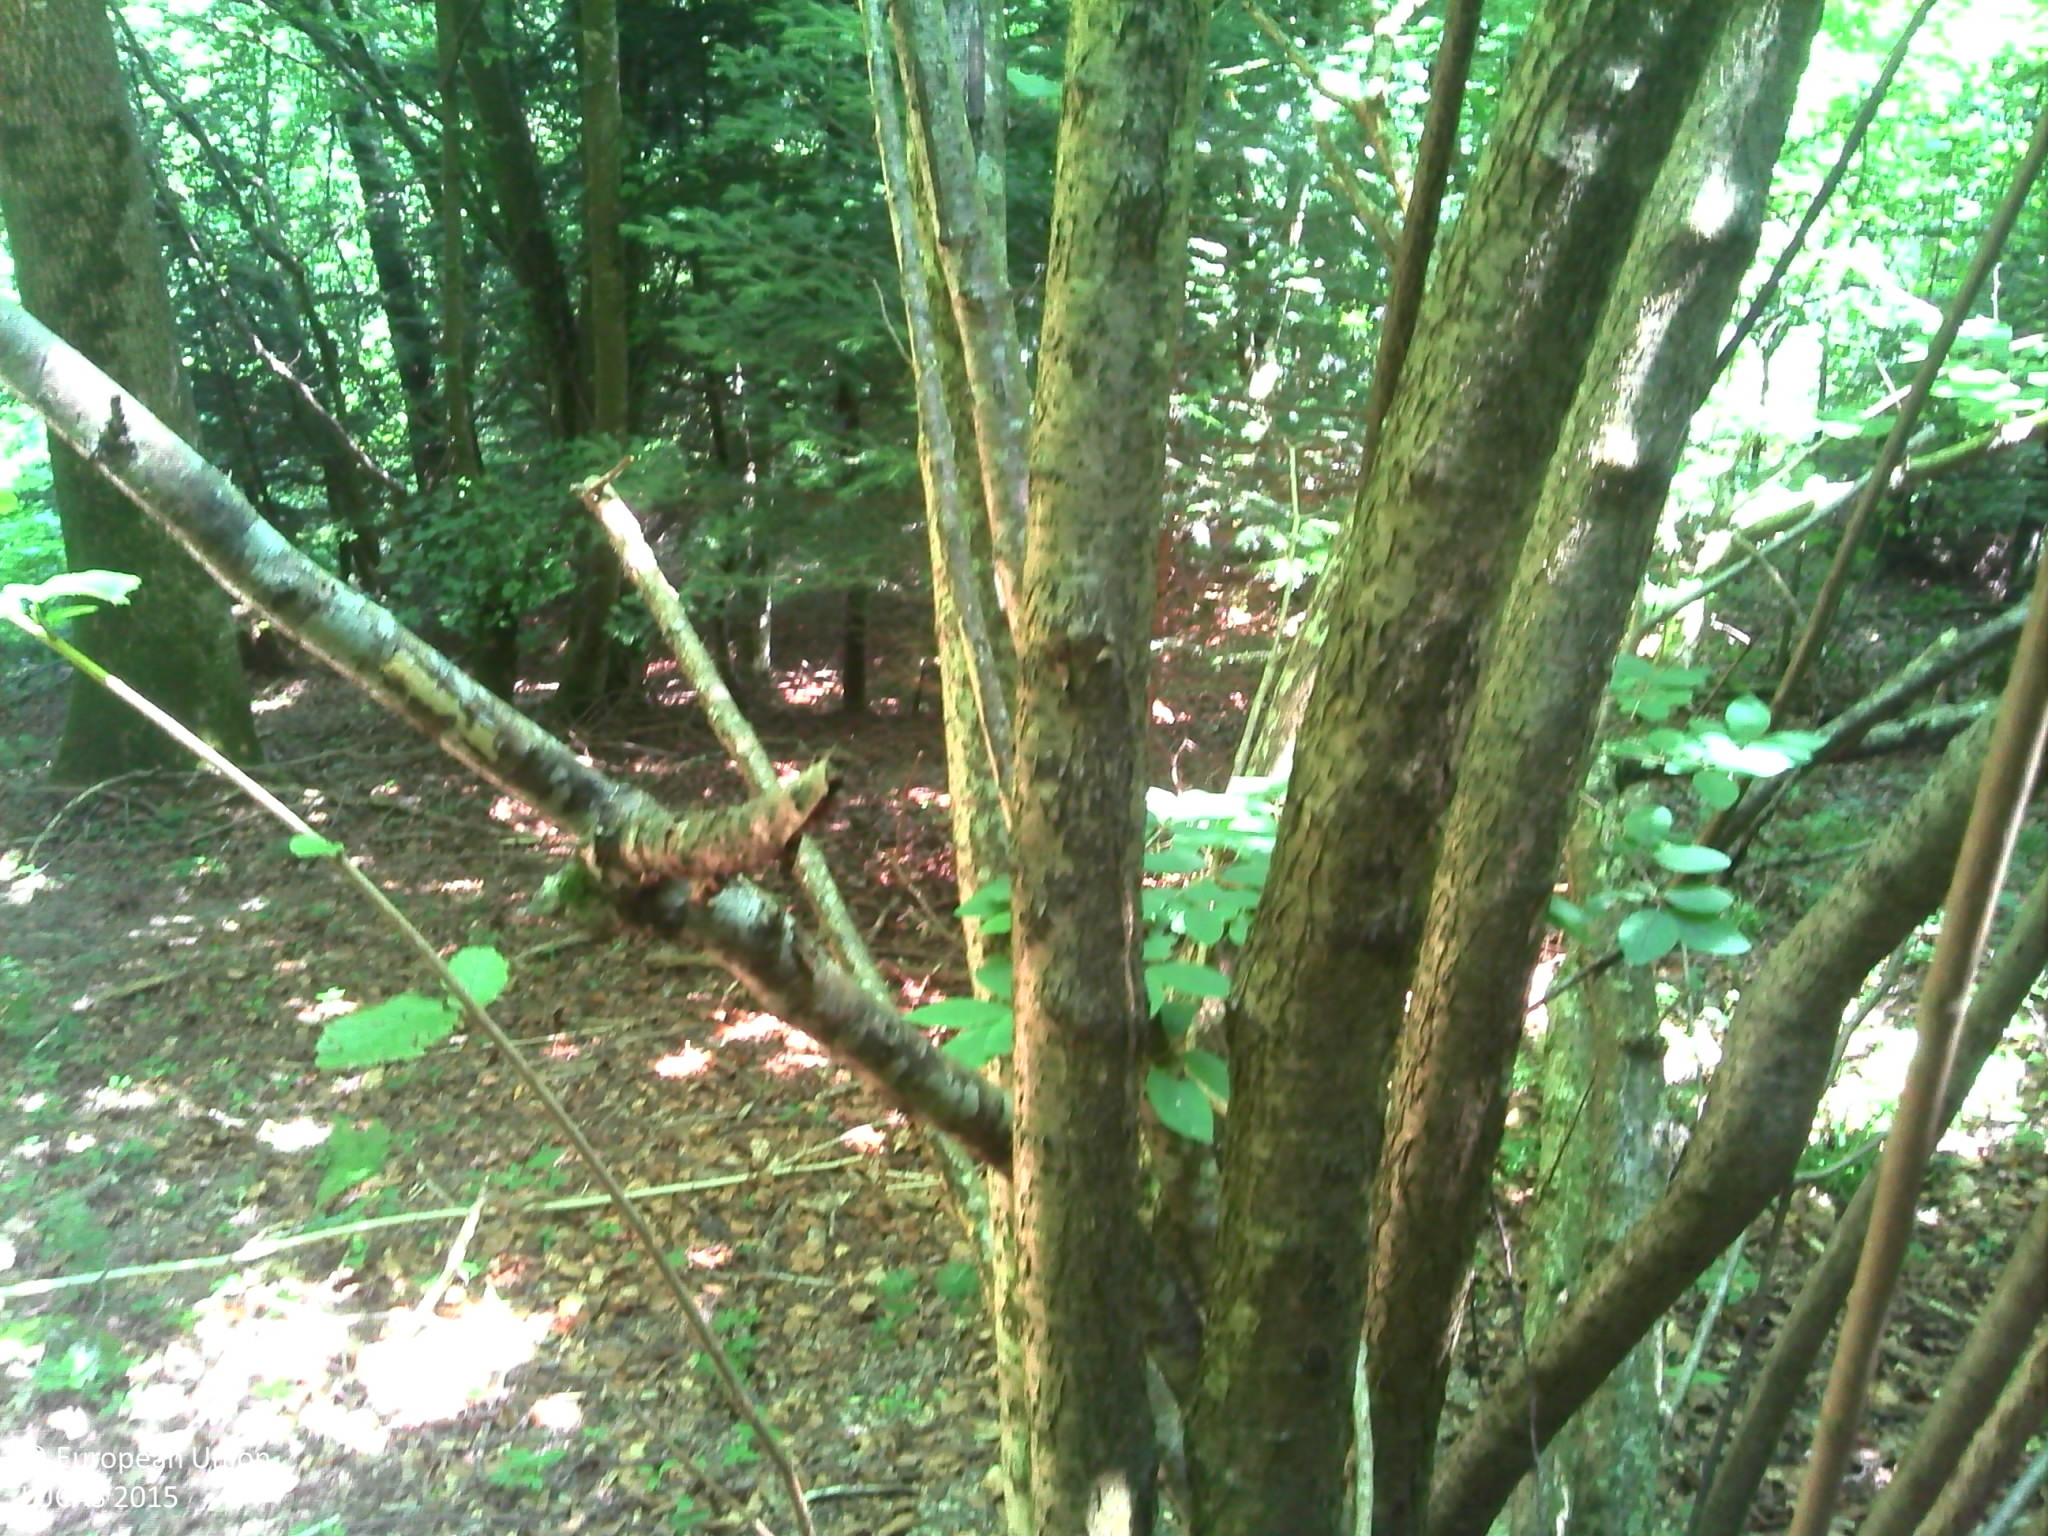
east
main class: Woodland
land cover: Spruce dominated mixed woodland
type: mountainous beech forest
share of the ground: > 75 %
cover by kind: broadleaved forest trees 40 %, coniferous forest trees 35 %, herbaceous plants 20 %, lichens and mosses 5 %
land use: Forestry
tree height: > 5 m
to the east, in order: Spruce dominated mixed woodland; Tracks; Spruce dominated mixed woodland; Grassland without tree/shrub cover; Spruce dominated mixed woodland
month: July
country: FR
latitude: 45.8871
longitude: 6.2026
